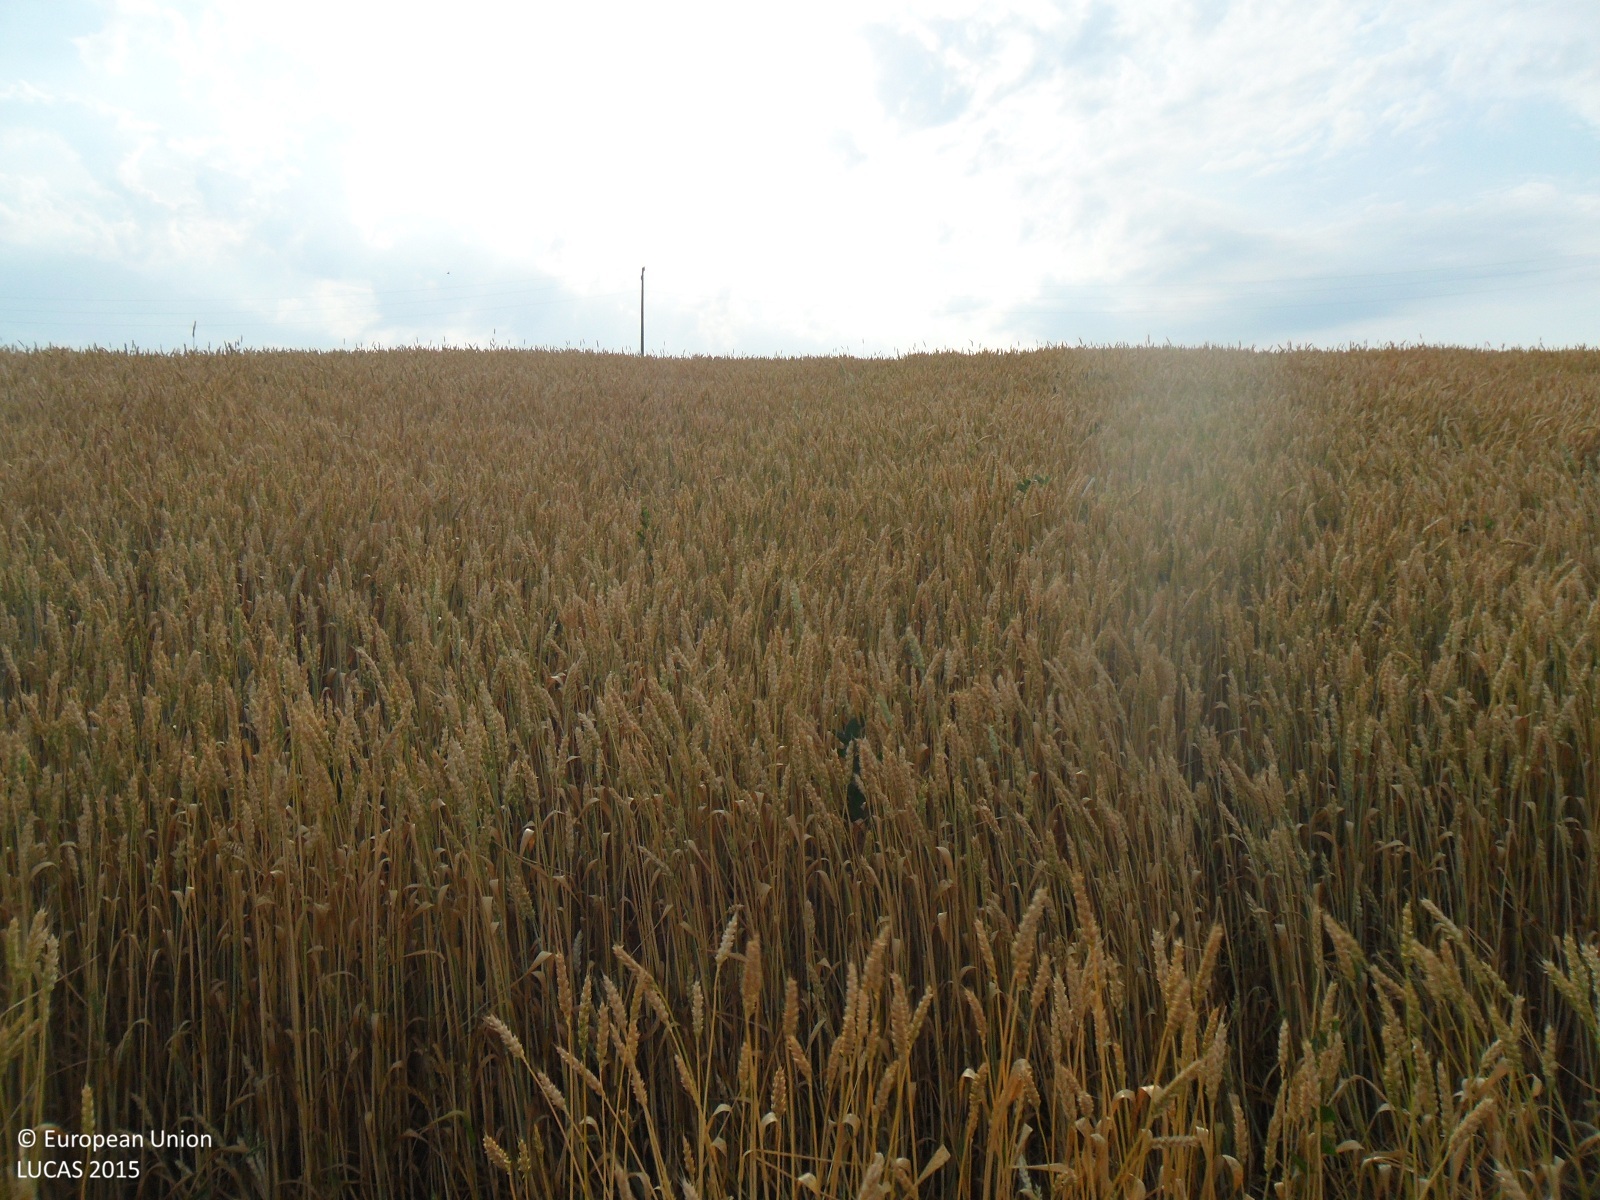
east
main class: Cropland
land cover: Common wheat
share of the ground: > 75 %
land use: Agriculture (excluding fallow land and kitchen gardens)
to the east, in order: Common wheat; Electric lines; Common wheat; Shrubland without tree cover
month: June
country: BG
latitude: 43.7779
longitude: 26.8018
